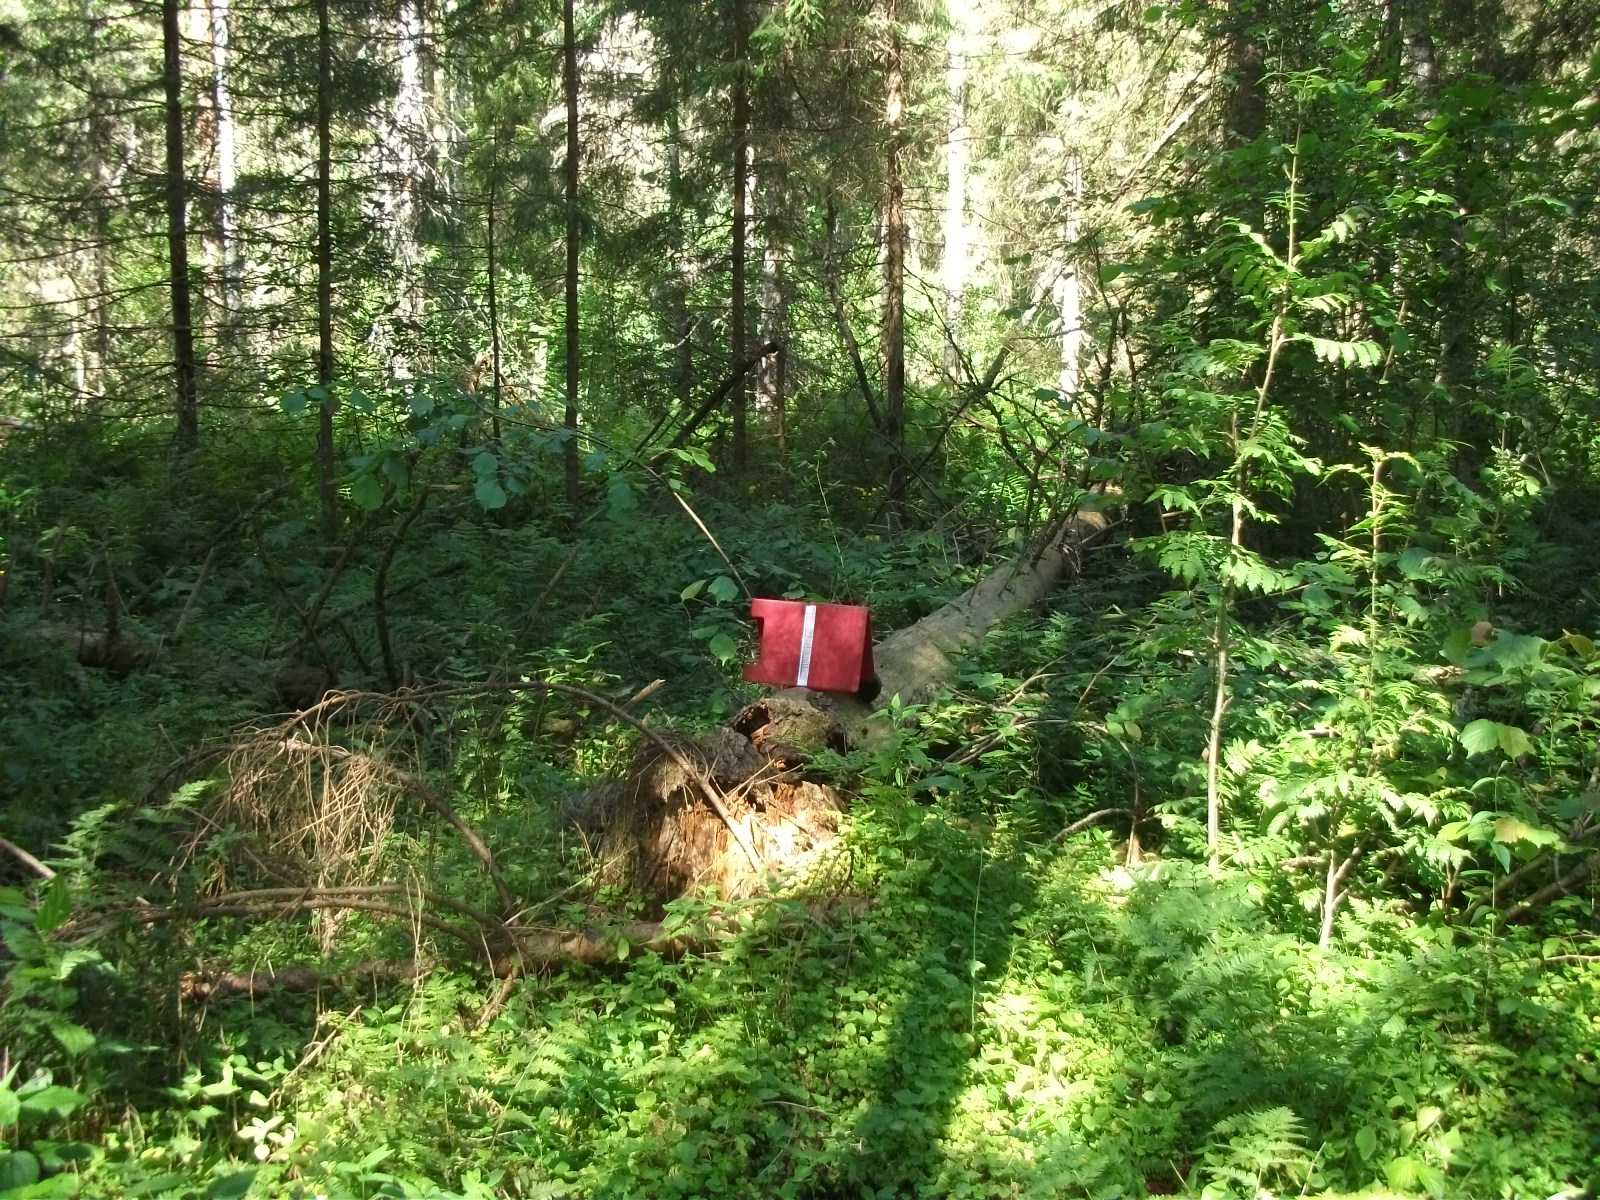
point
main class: Woodland
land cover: Spruce dominated coniferous woodland
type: hemiboreal forest and nemoral coniferous forest and mixed broadleaved-coniferous forest
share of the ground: > 75 %
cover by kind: coniferous forest trees 75 %, broadleaved forest trees 10 %, shrubs 10 %, herbaceous plants 5 %
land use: Forestry
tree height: > 5 m
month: July
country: LV
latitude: 56.7545
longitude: 26.1481
